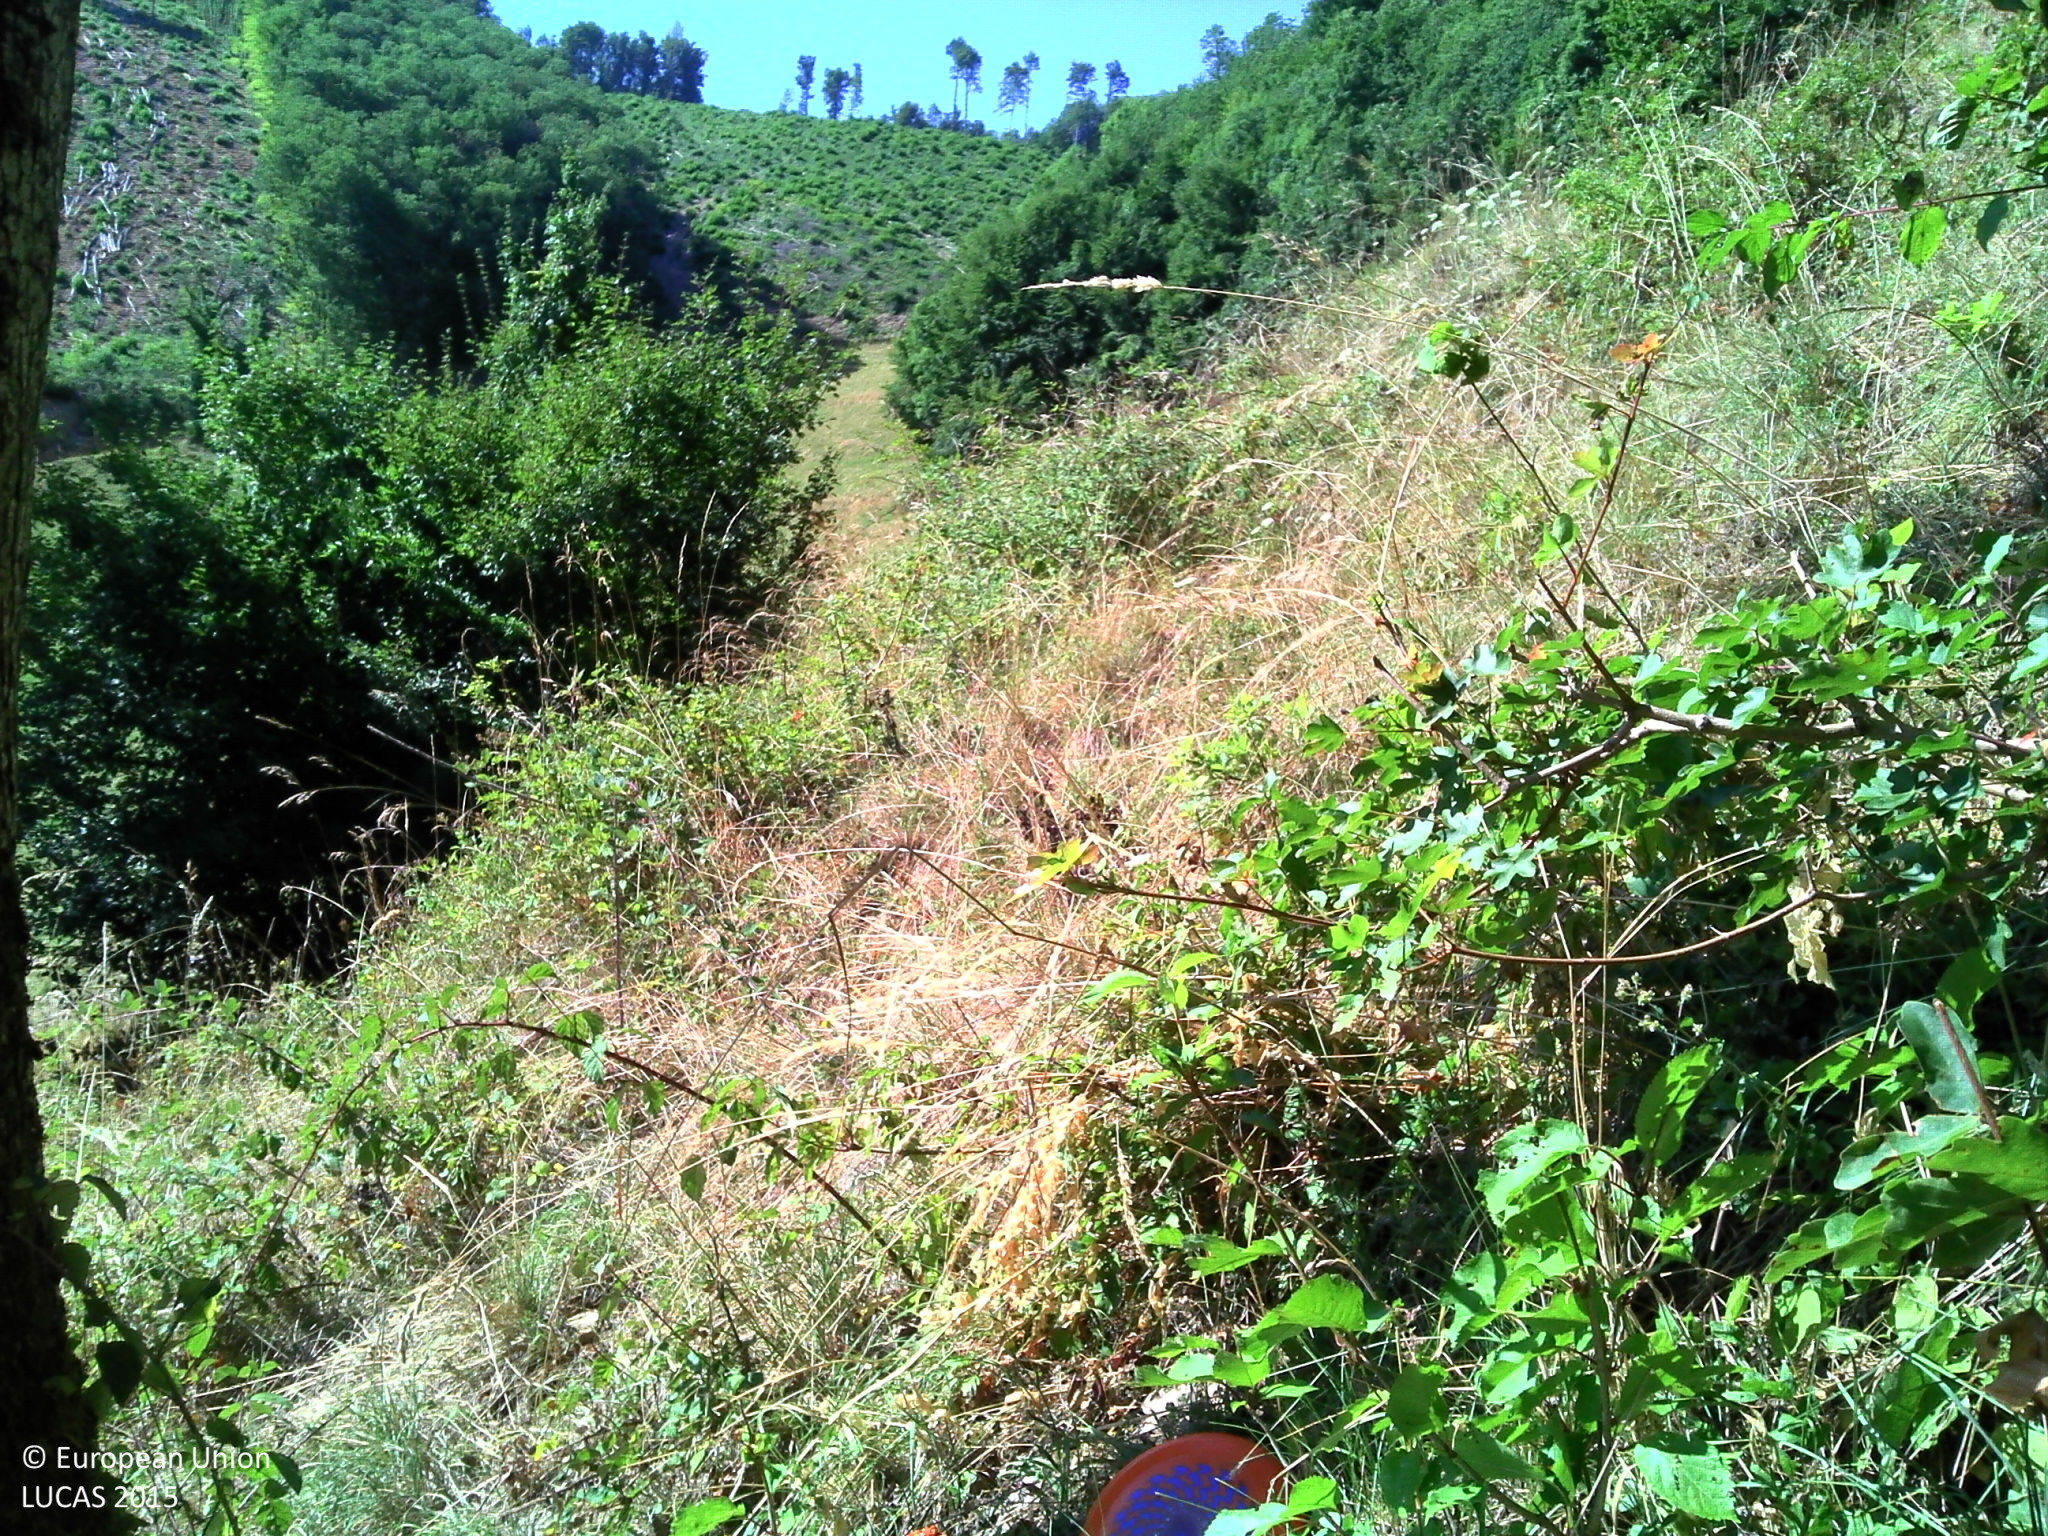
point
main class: Shrubland
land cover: Shrubland without tree cover
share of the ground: > 75 %
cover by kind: herbaceous plants 65 %, shrubs 35 %
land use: Agriculture (excluding fallow land and kitchen gardens)
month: July
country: FR
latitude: 45.2982
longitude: 5.4526
